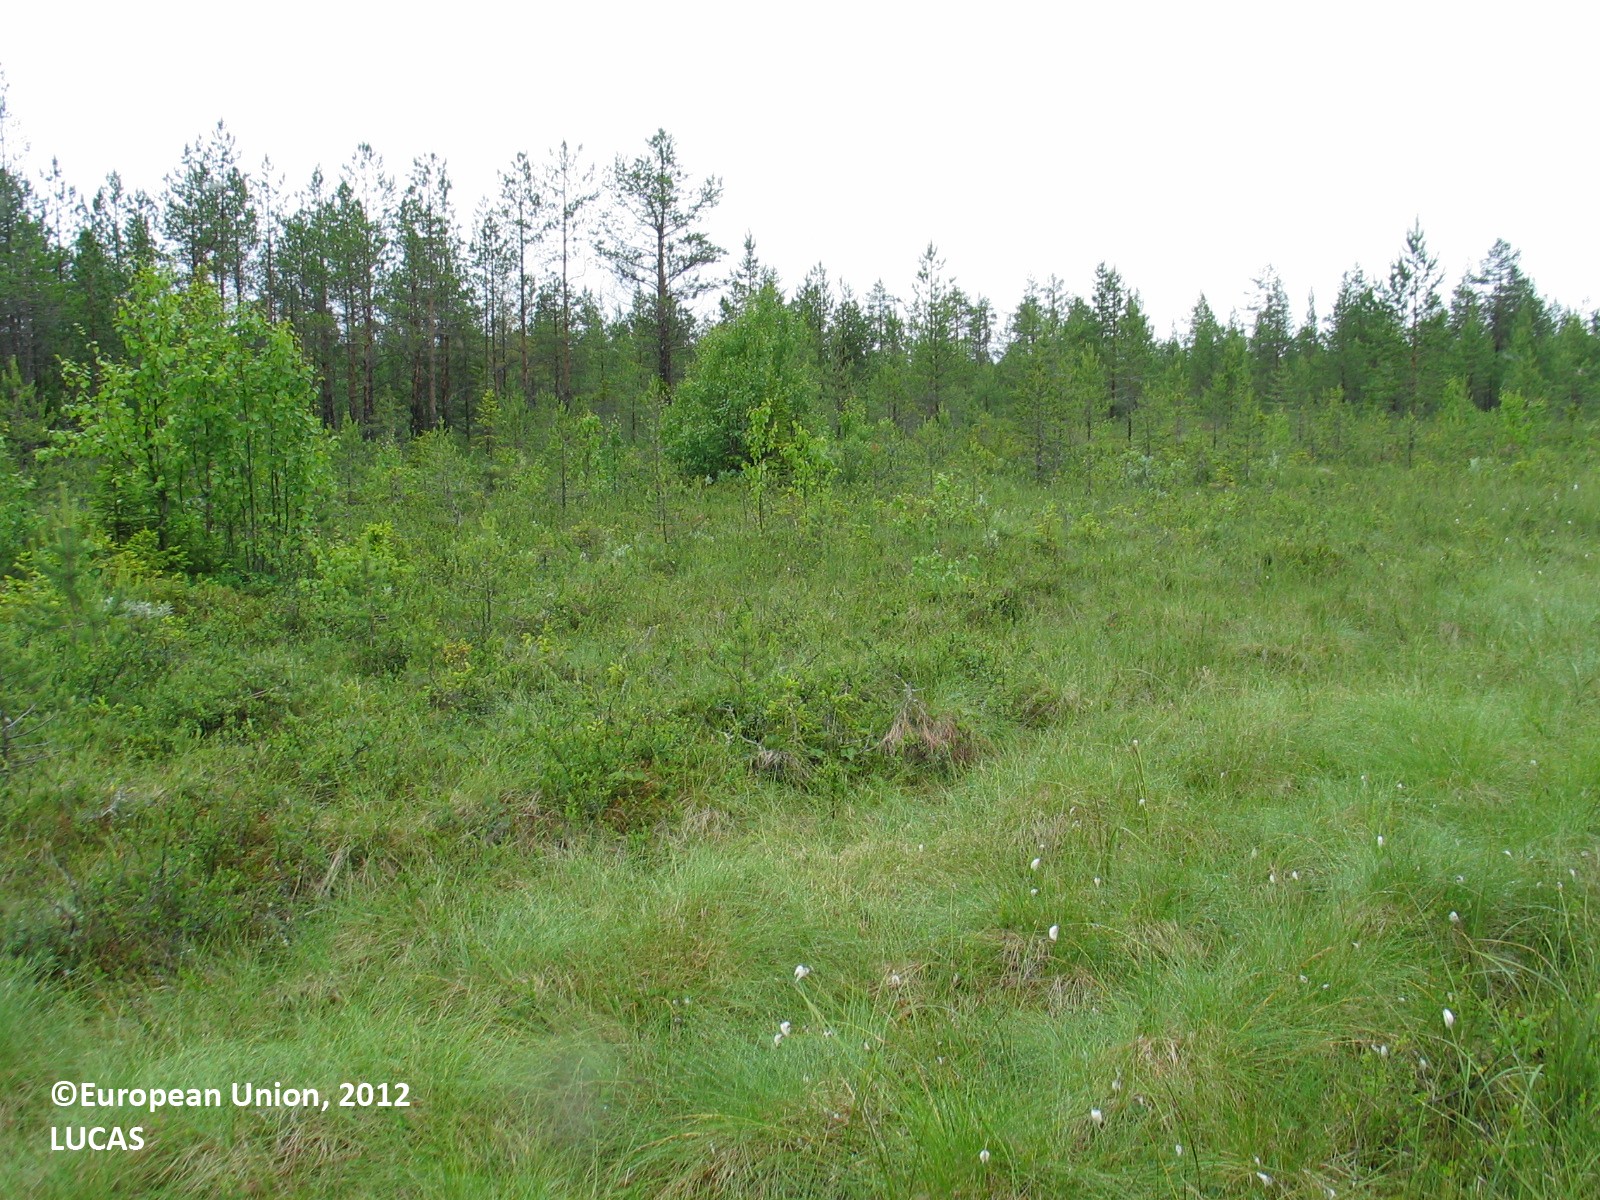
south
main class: Grassland
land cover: Grassland without tree/shrub cover
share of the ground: > 75 %
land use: Energy production
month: July
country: FI
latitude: 66.0444
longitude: 25.0025
